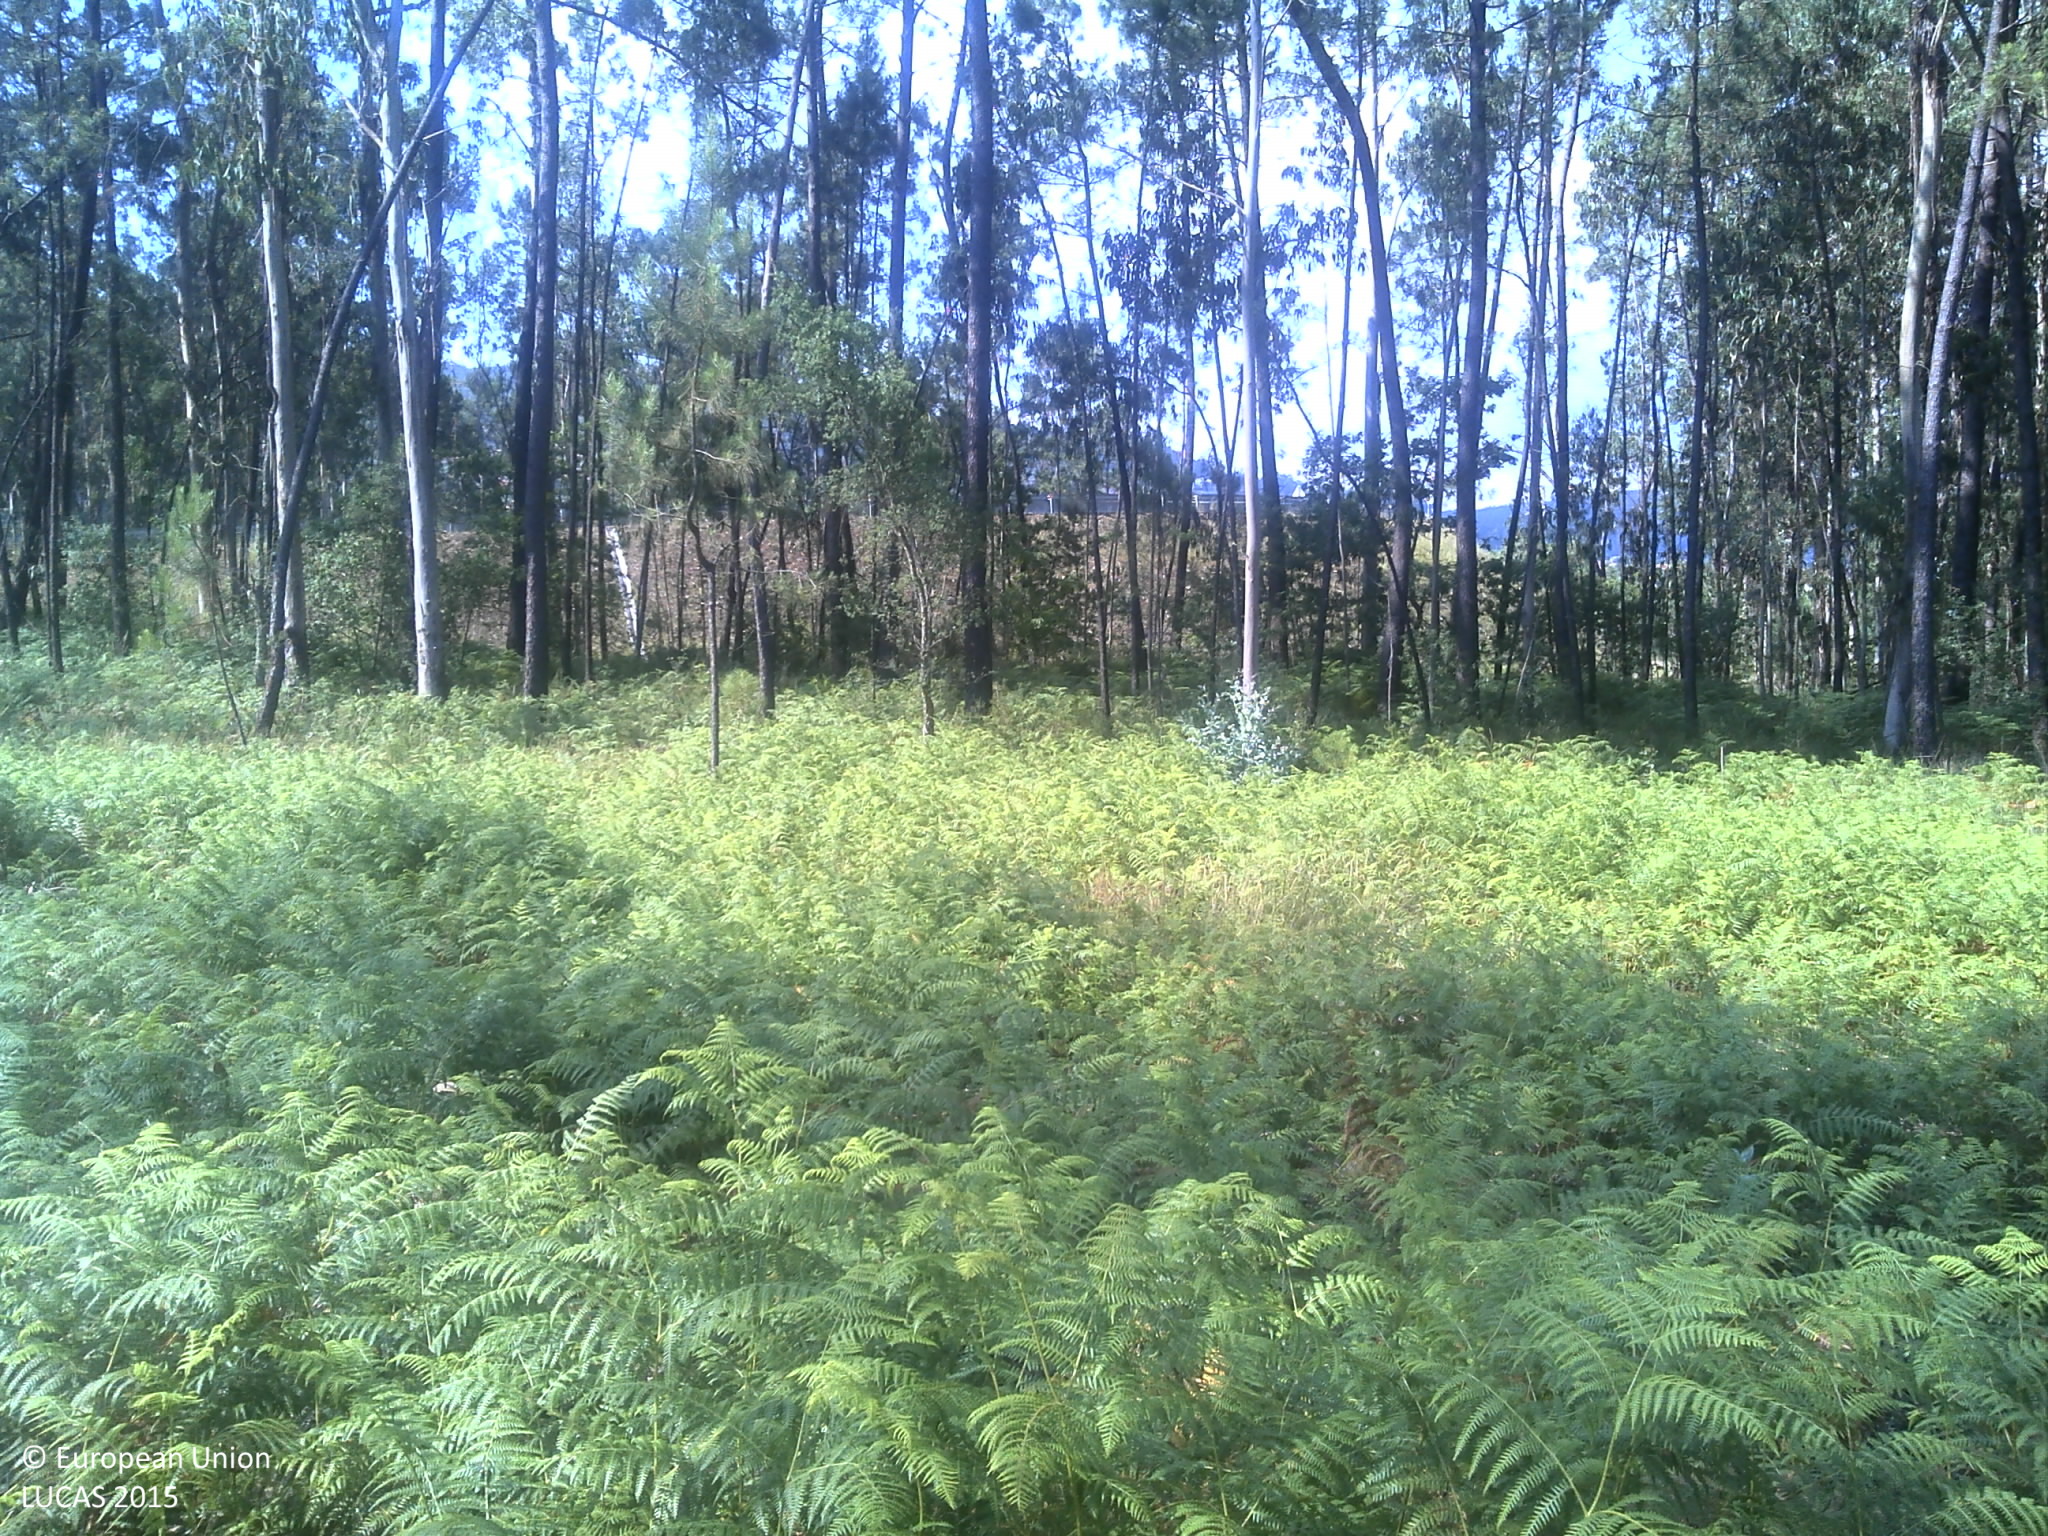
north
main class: Woodland
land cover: Pine dominated mixed woodland
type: coniferous forest of the mediterranean region
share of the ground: 25 - 50 %
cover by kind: coniferous forest trees 75 %, broadleaved forest trees 25 %
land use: Forestry
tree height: > 5 m
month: June
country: PT
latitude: 41.5707
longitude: -8.6412
